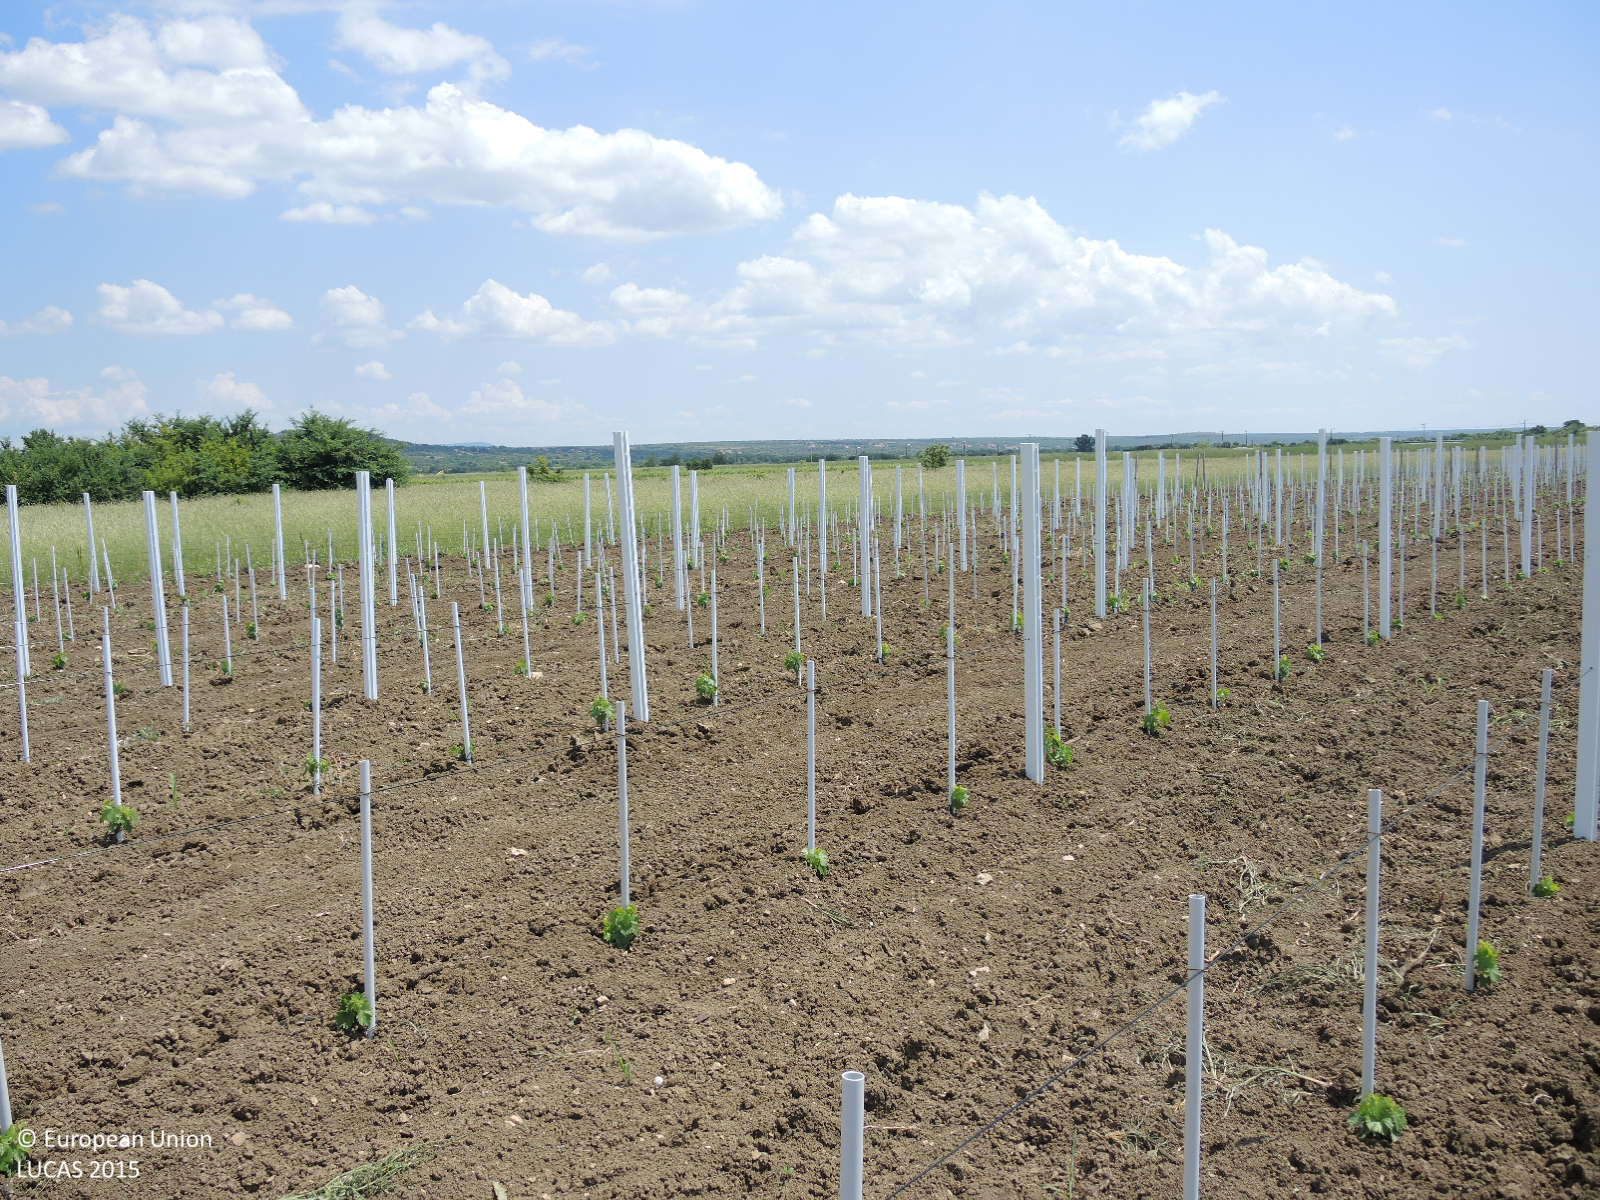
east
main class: Cropland
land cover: Vineyards
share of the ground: < 10 %
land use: Agriculture (excluding fallow land and kitchen gardens)
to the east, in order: Vineyards; Grassland without tree/shrub cover; Shrubland without tree cover; Tracks; Shrubland without tree cover; Grassland without tree/shrub cover; Vineyards
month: May
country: HR
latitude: 44.0423
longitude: 15.4954
